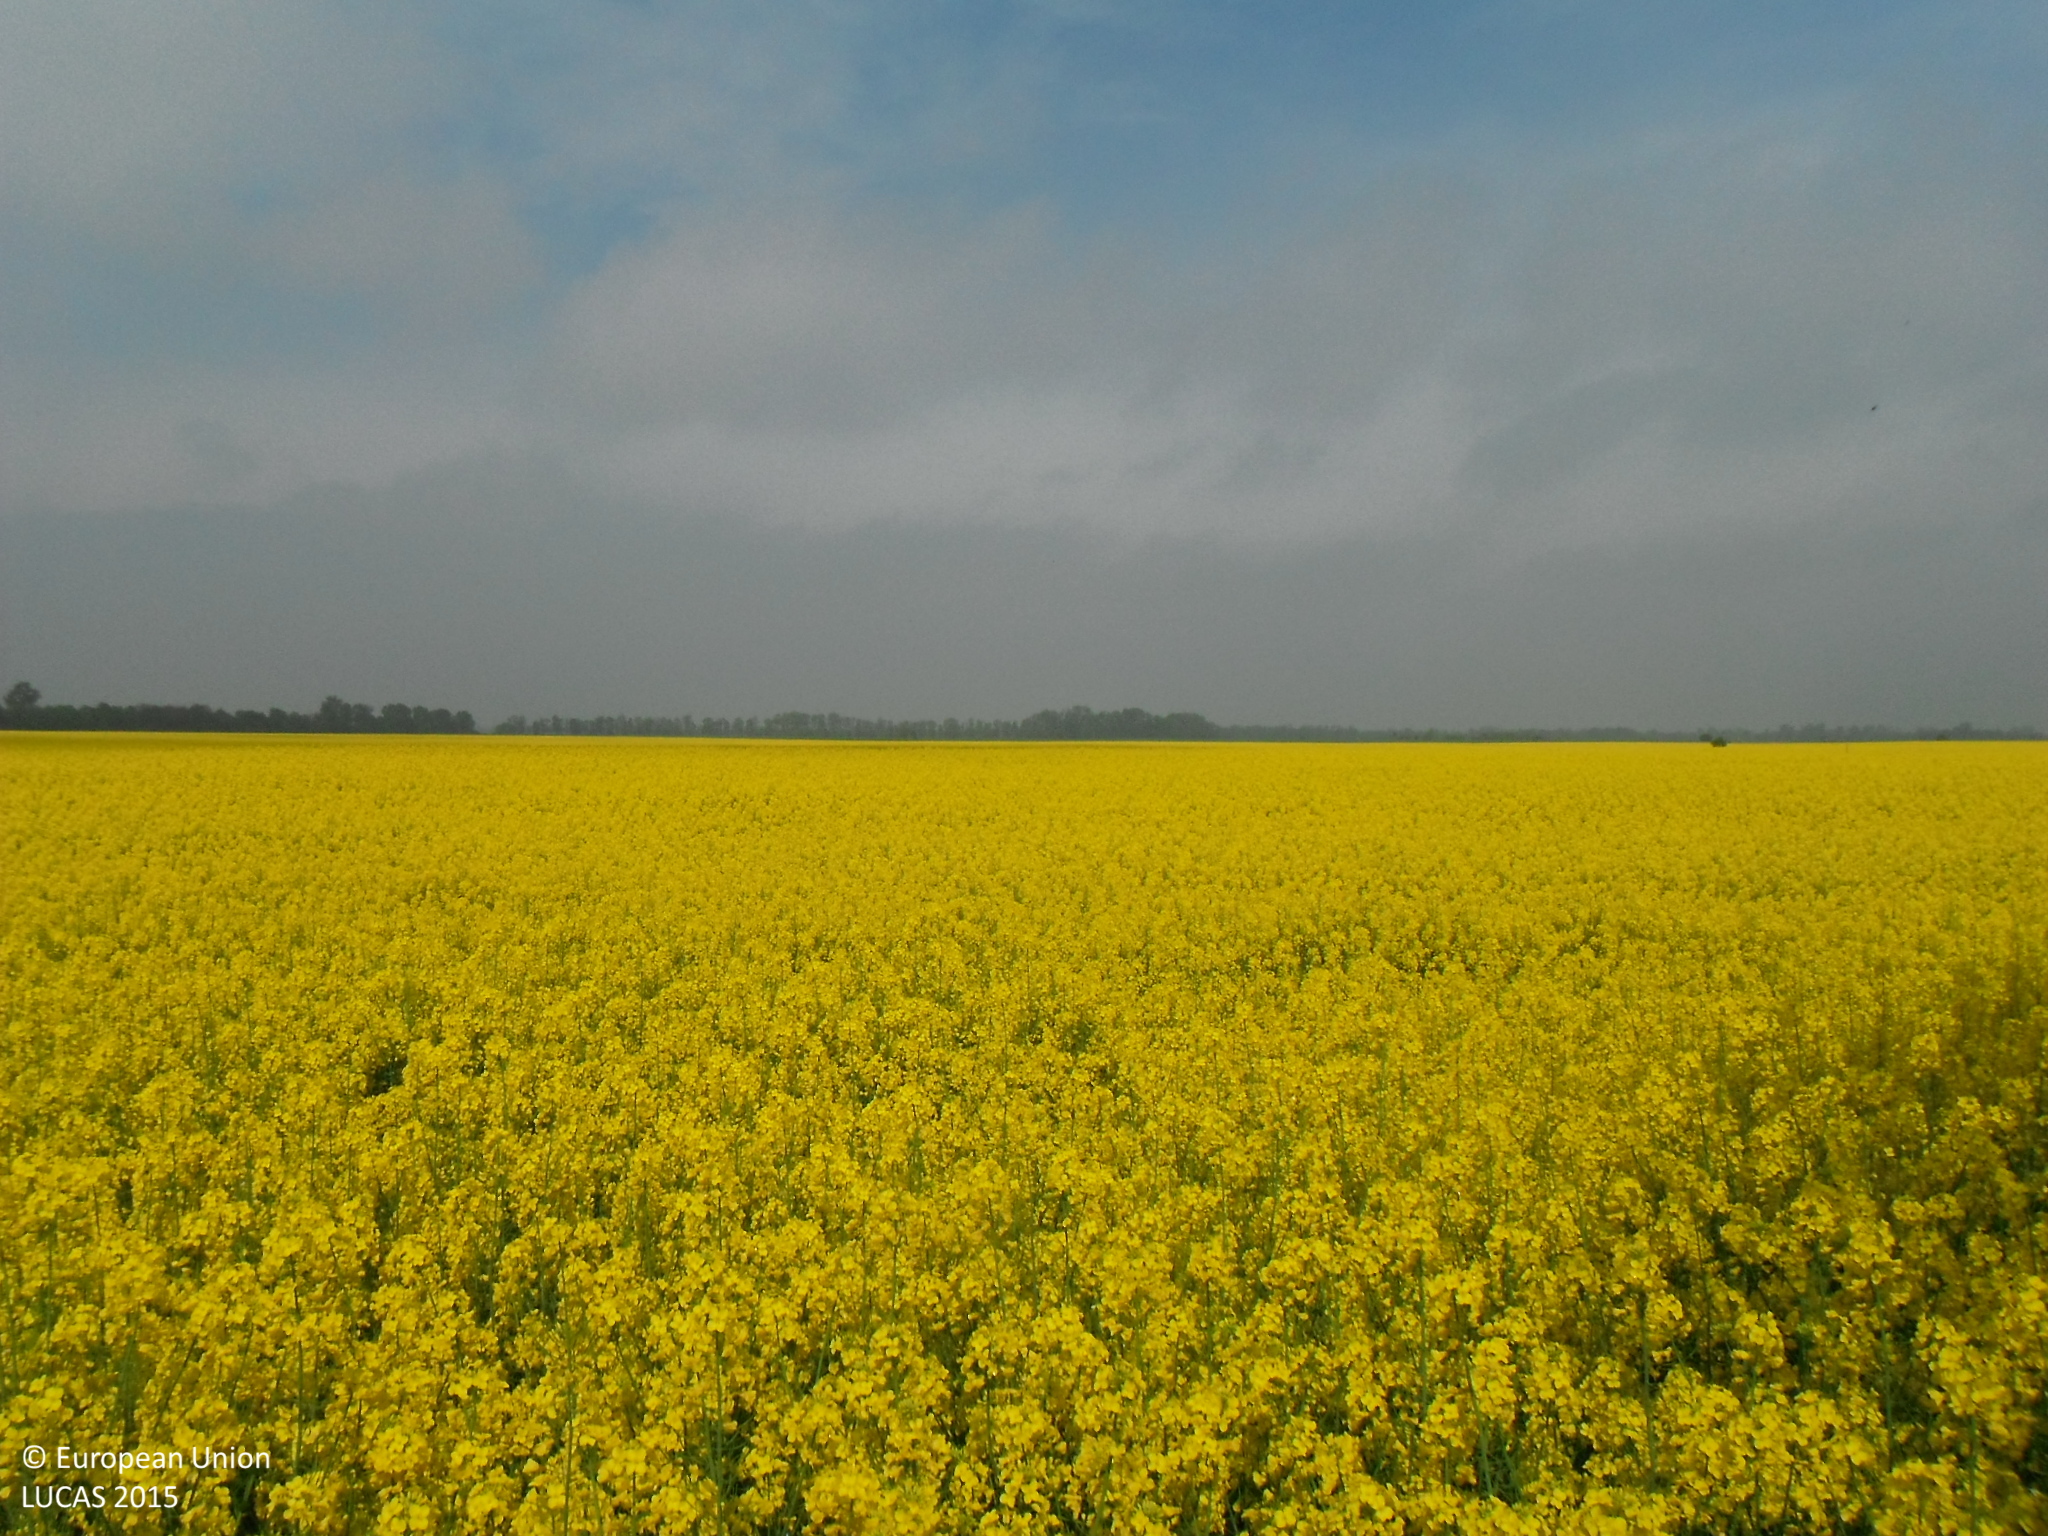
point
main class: Cropland
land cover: Rape and turnip rape
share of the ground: > 75 %
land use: Agriculture (excluding fallow land and kitchen gardens)
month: May
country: SK
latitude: 48.0523
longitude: 17.3205
